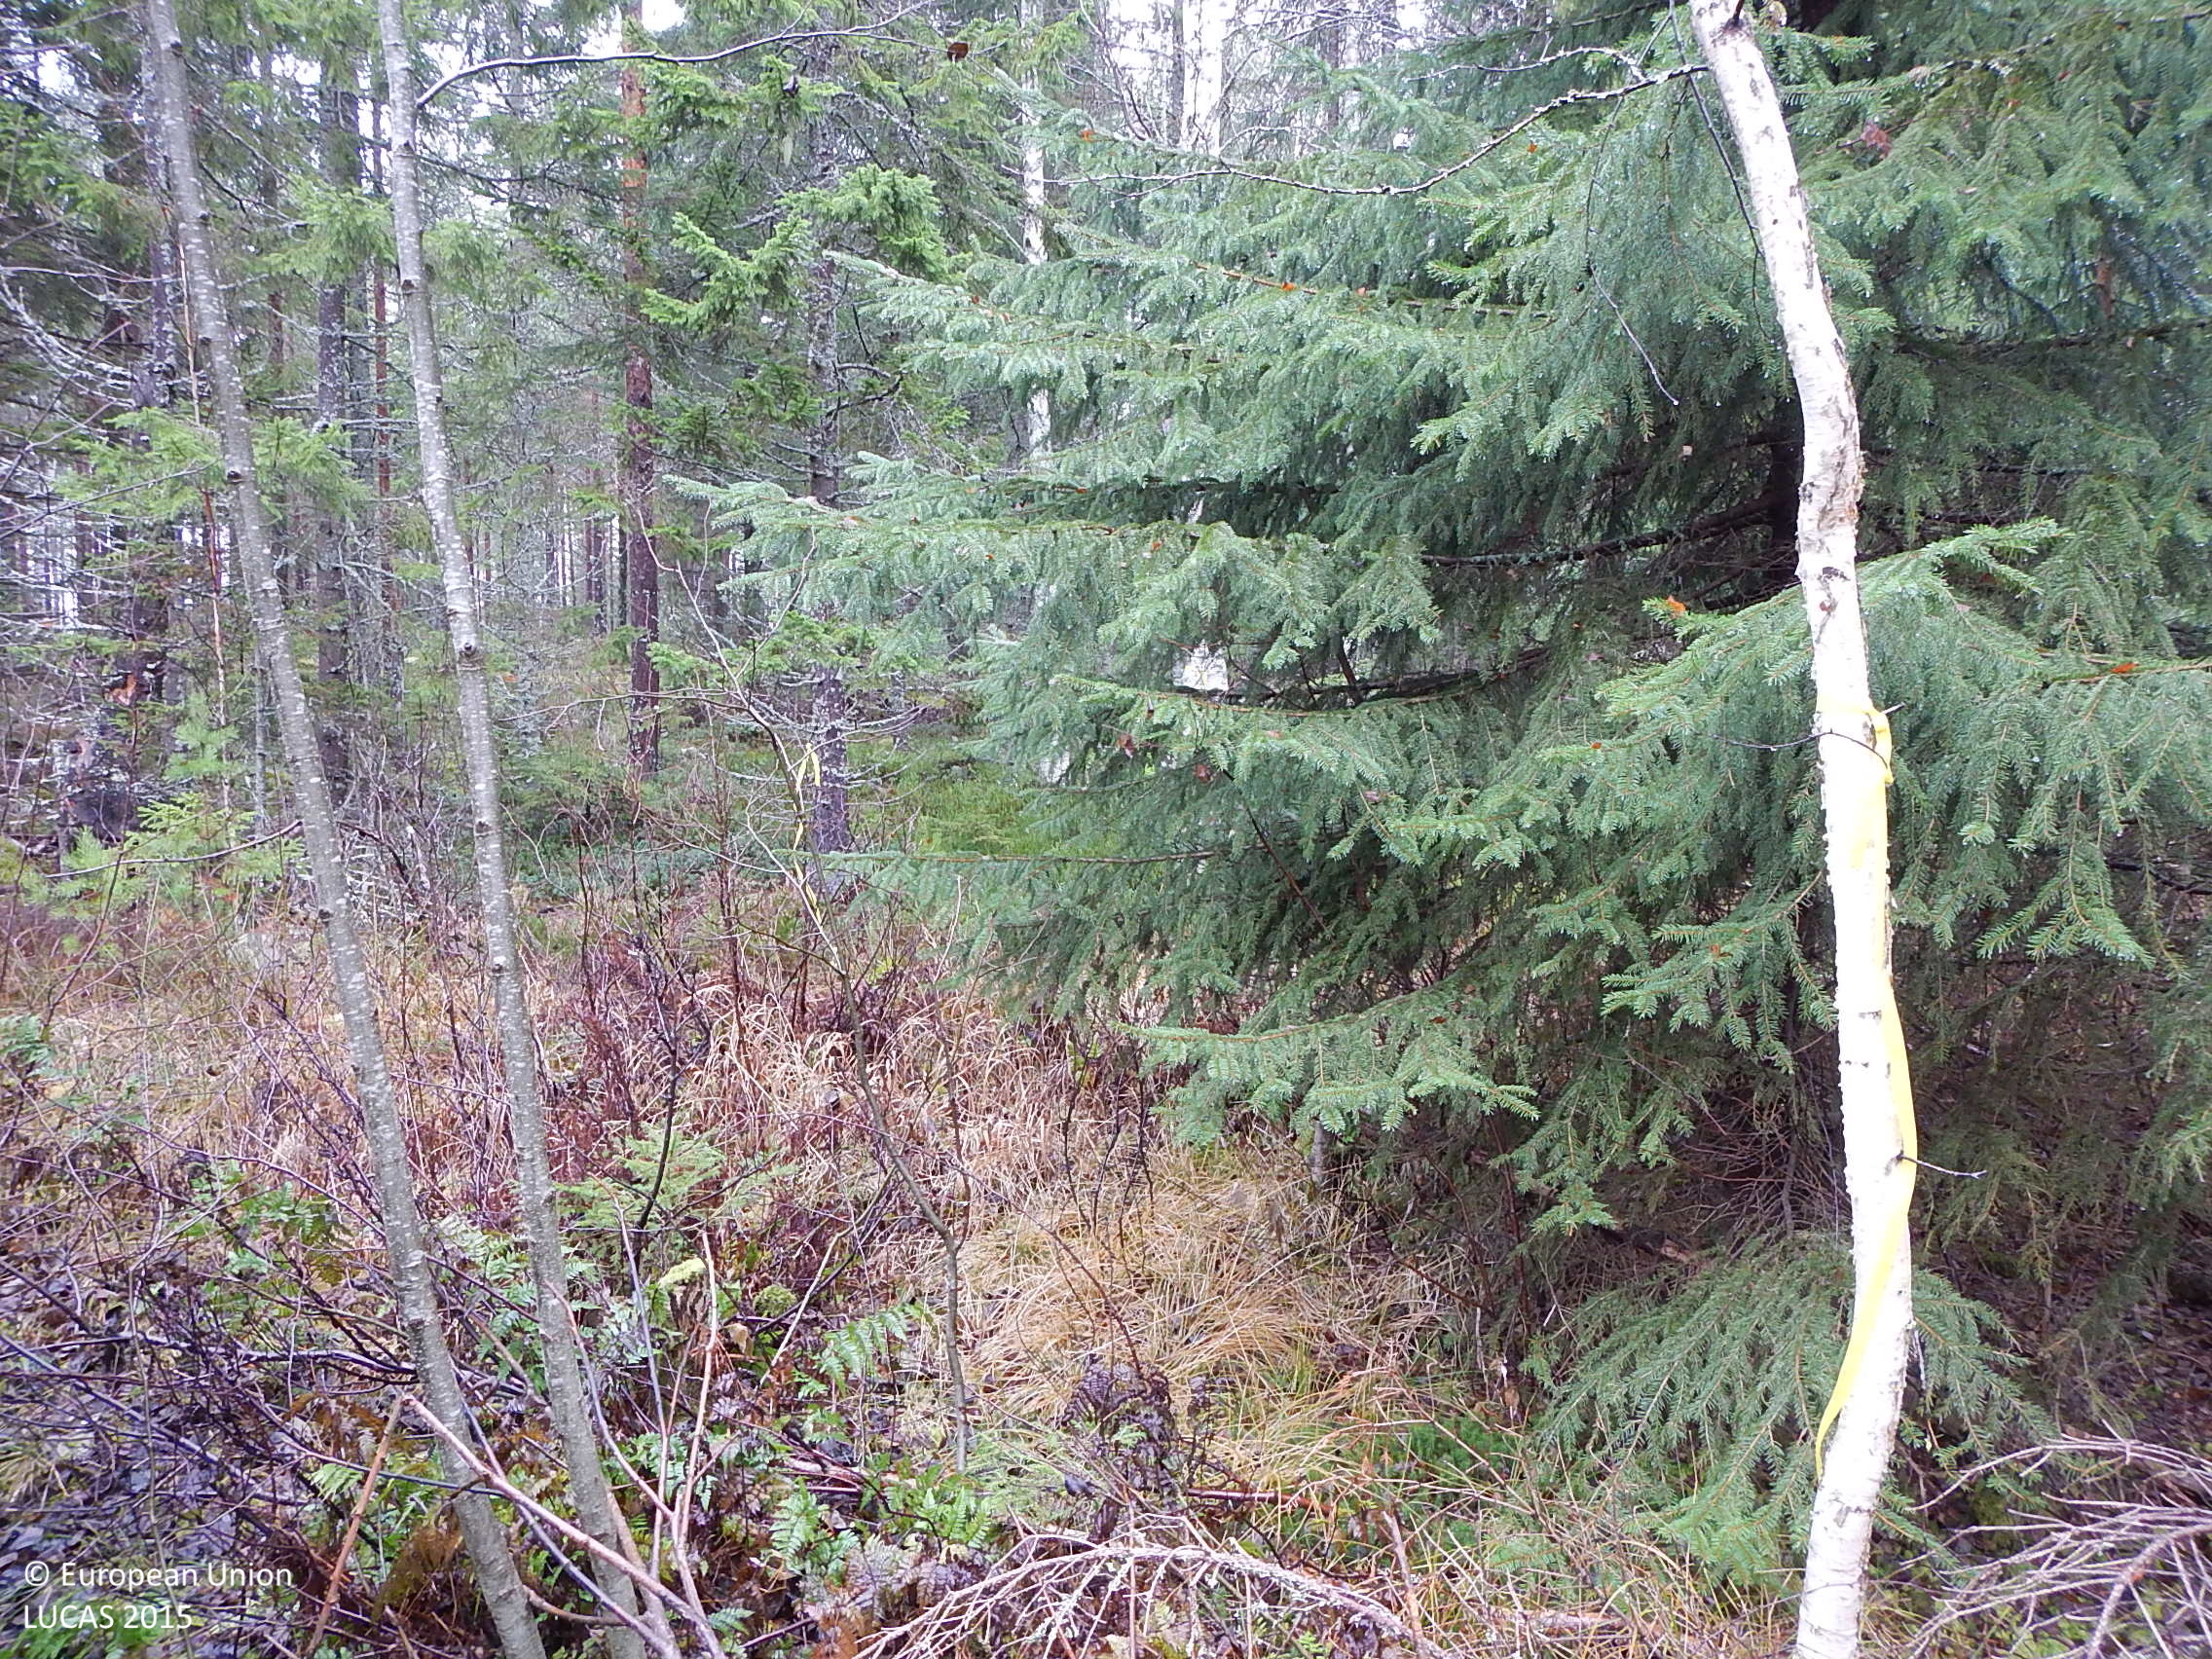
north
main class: Woodland
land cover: Spruce dominated mixed woodland
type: boreal forest
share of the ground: > 75 %
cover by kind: broadleaved forest trees 50 %, coniferous forest trees 35 %, herbaceous plants 5 %
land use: Forestry
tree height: > 5 m
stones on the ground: < 10 %
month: November
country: SE
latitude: 61.3473
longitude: 16.9588
